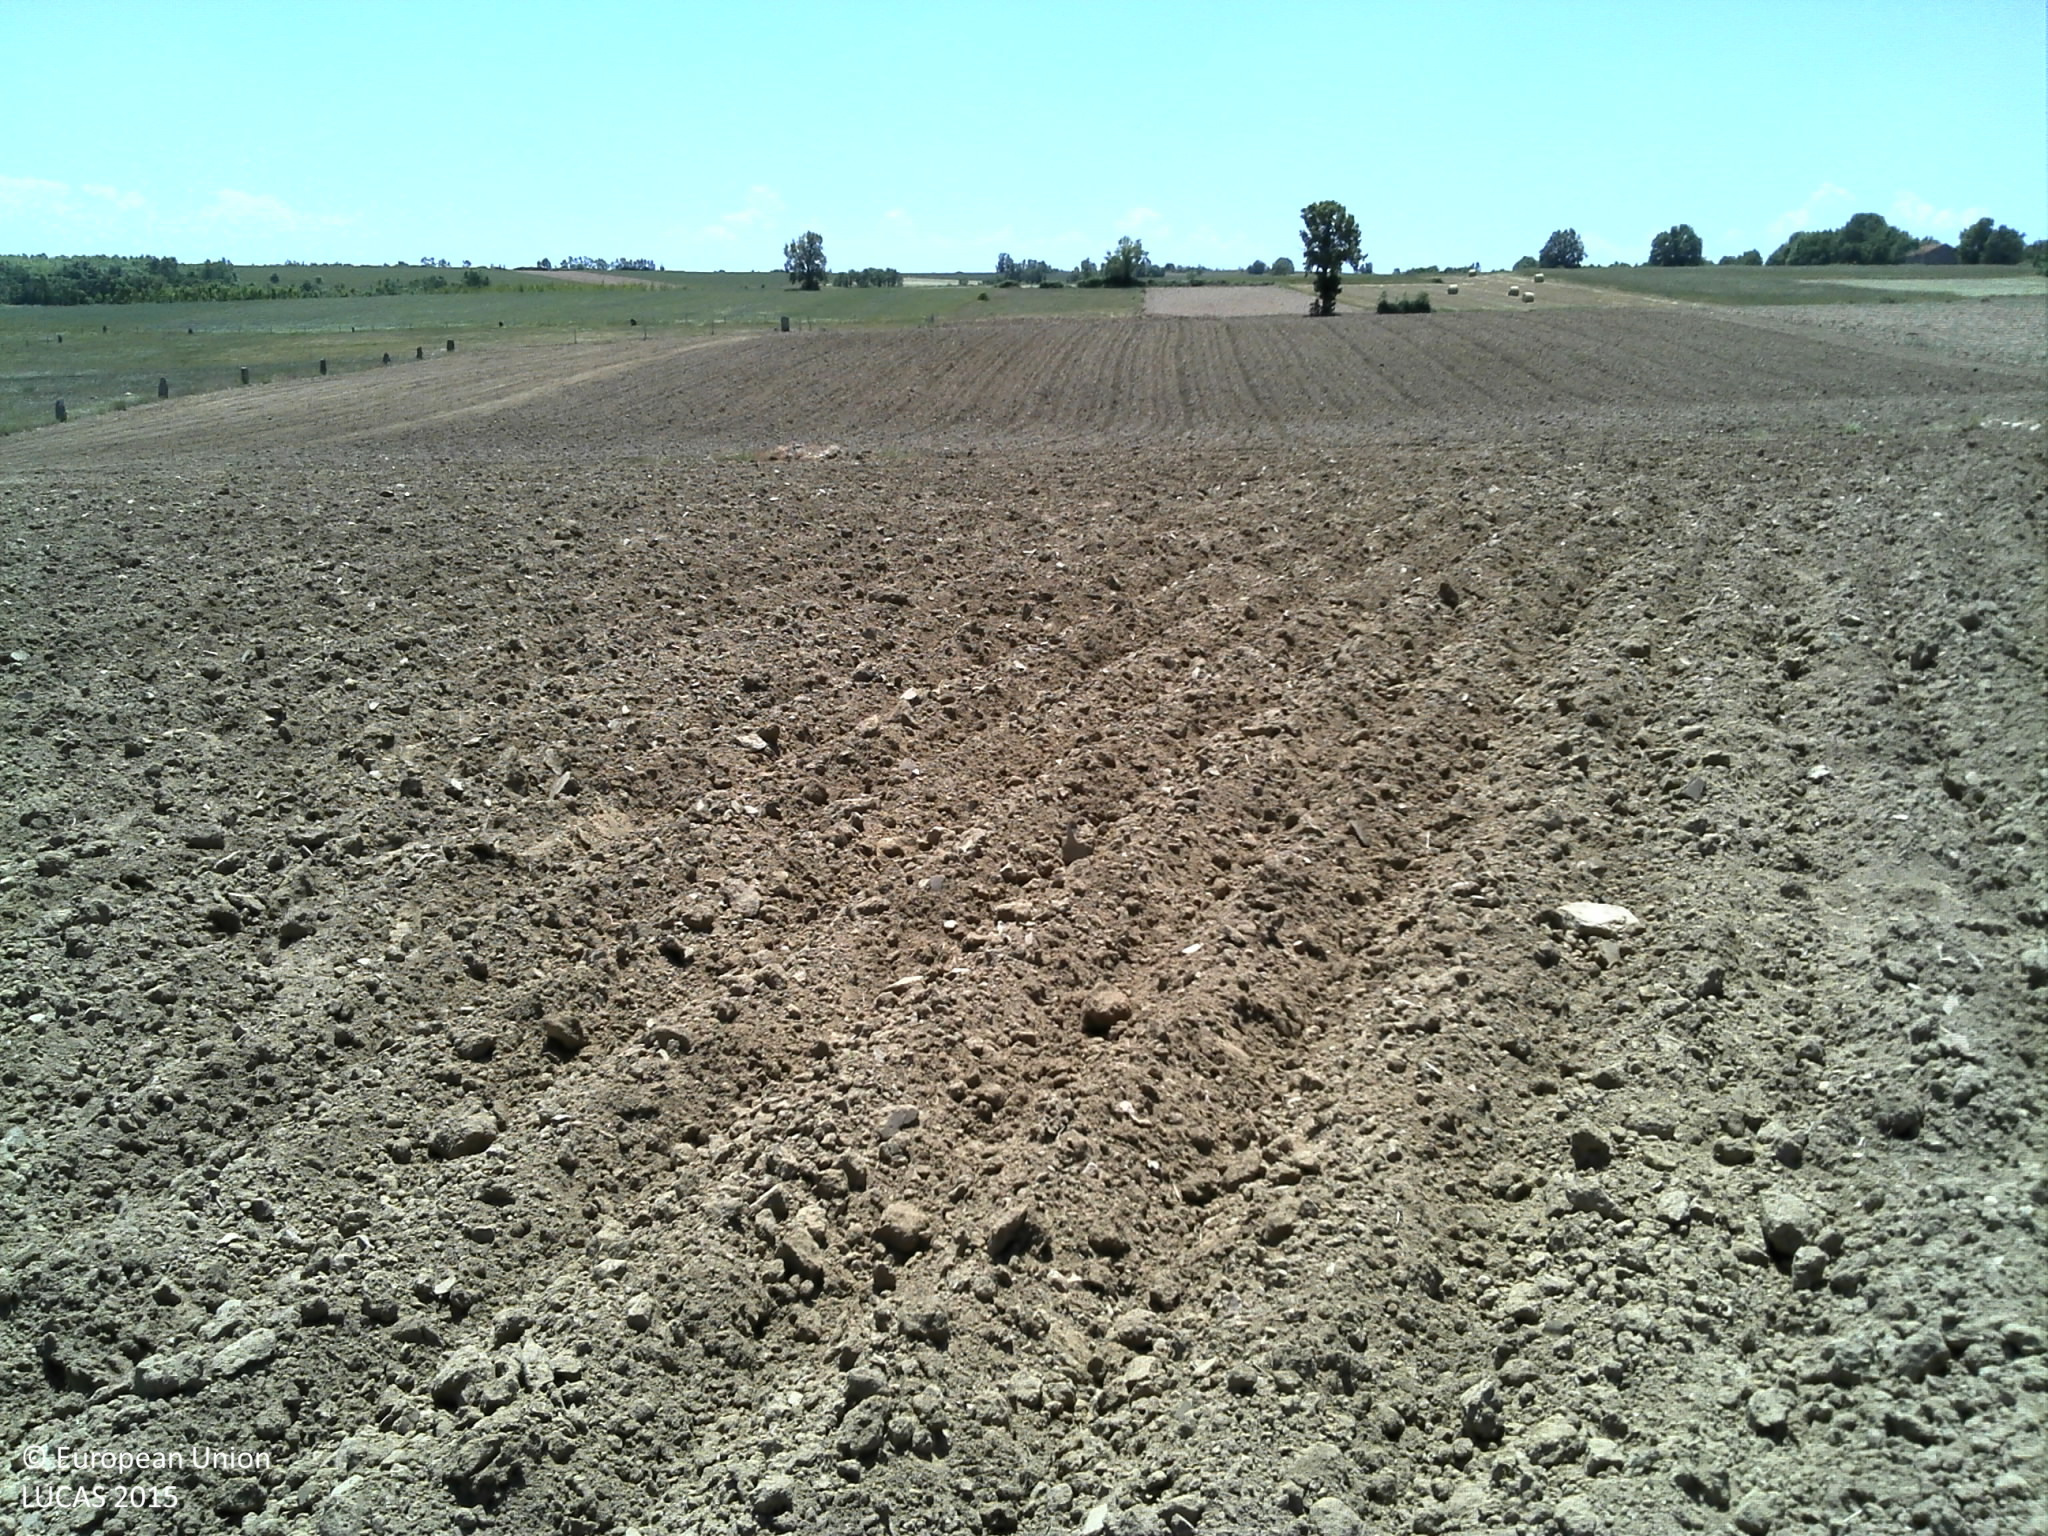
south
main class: Cropland
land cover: Oats
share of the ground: < 10 %
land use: Agriculture (excluding fallow land and kitchen gardens)
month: May
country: PT
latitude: 41.5371
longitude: -6.3411
